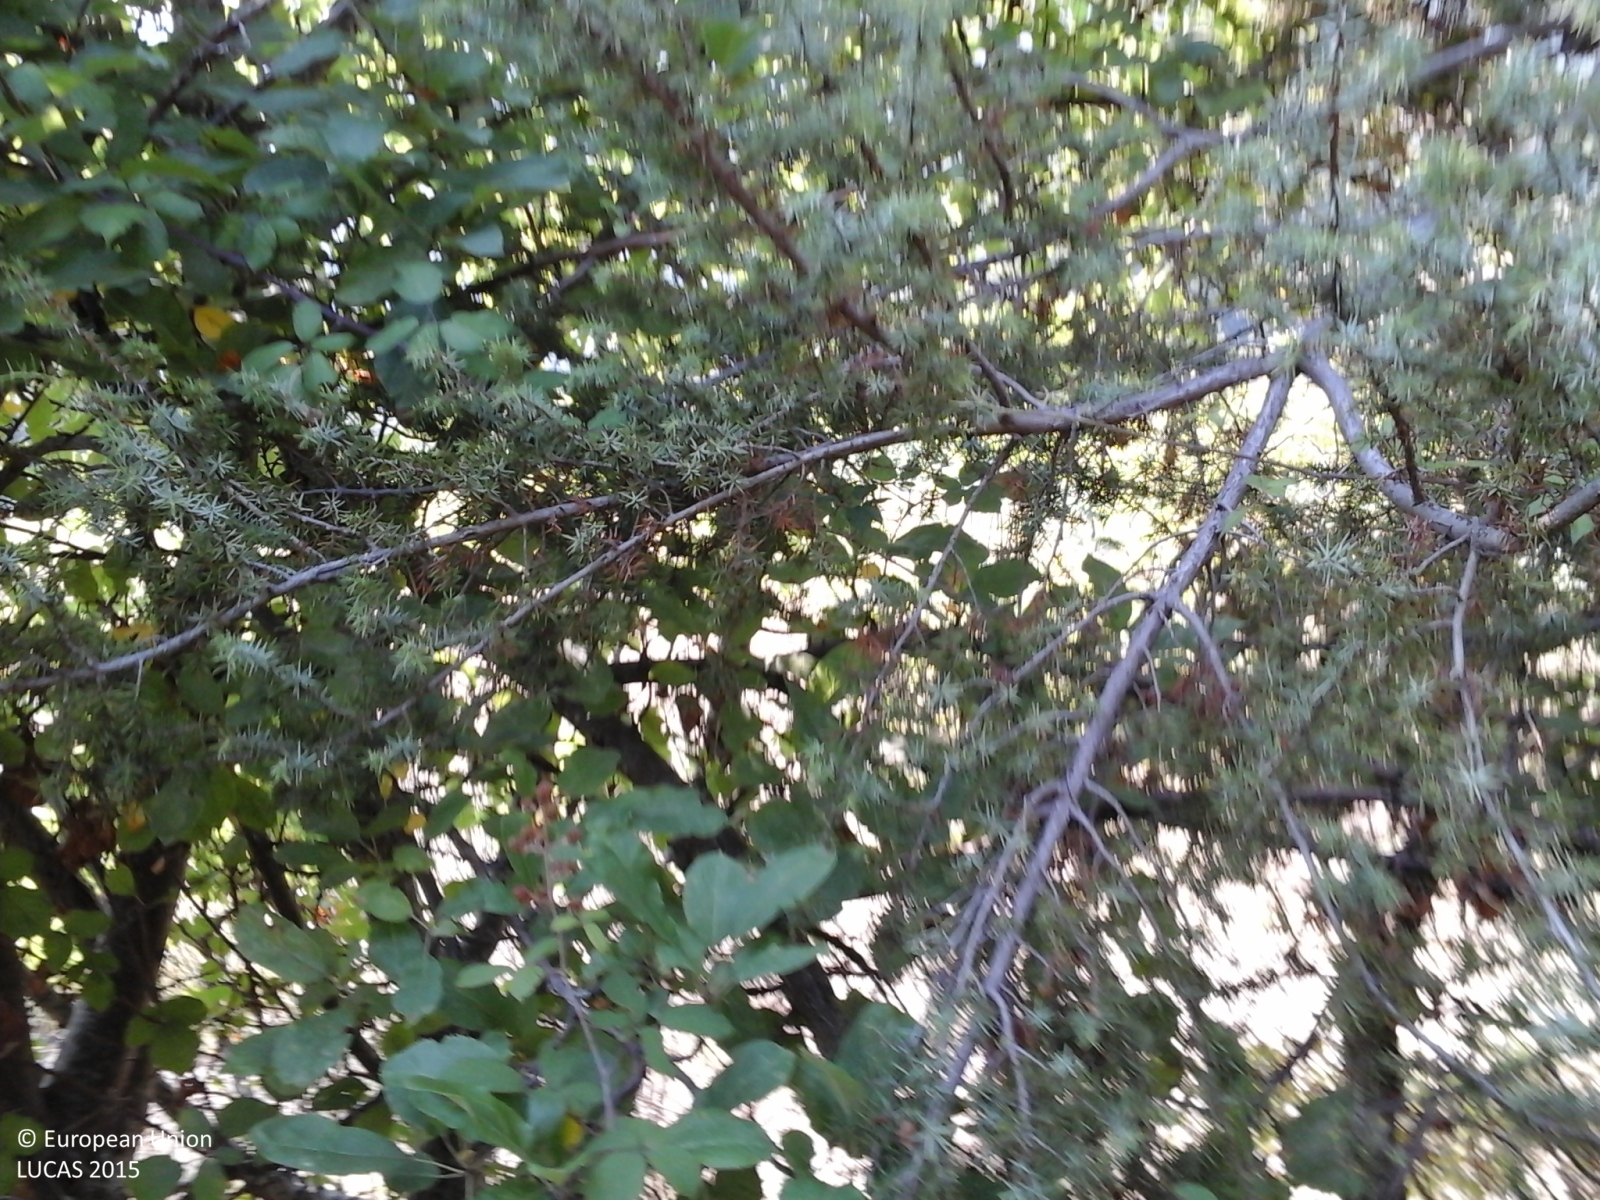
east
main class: Woodland
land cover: Broadleaved woodland
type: thermophilous deciduous forest
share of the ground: > 75 %
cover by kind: broadleaved forest trees 70 %, shrubs 15 %, coniferous forest trees 10 %, herbaceous plants 5 %
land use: Forestry
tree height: > 5 m
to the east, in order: Broadleaved woodland; Tracks; Lines of trees; Grass margins; Tracks; Other bare soil; Olive groves; Tracks; Olive groves; Artificial constructions in urban areas; Broadleaved woodland; Tracks; Broadleaved woodland; Ditches and canals; Tracks
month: August
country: IT
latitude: 44.0245
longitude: 12.0039
